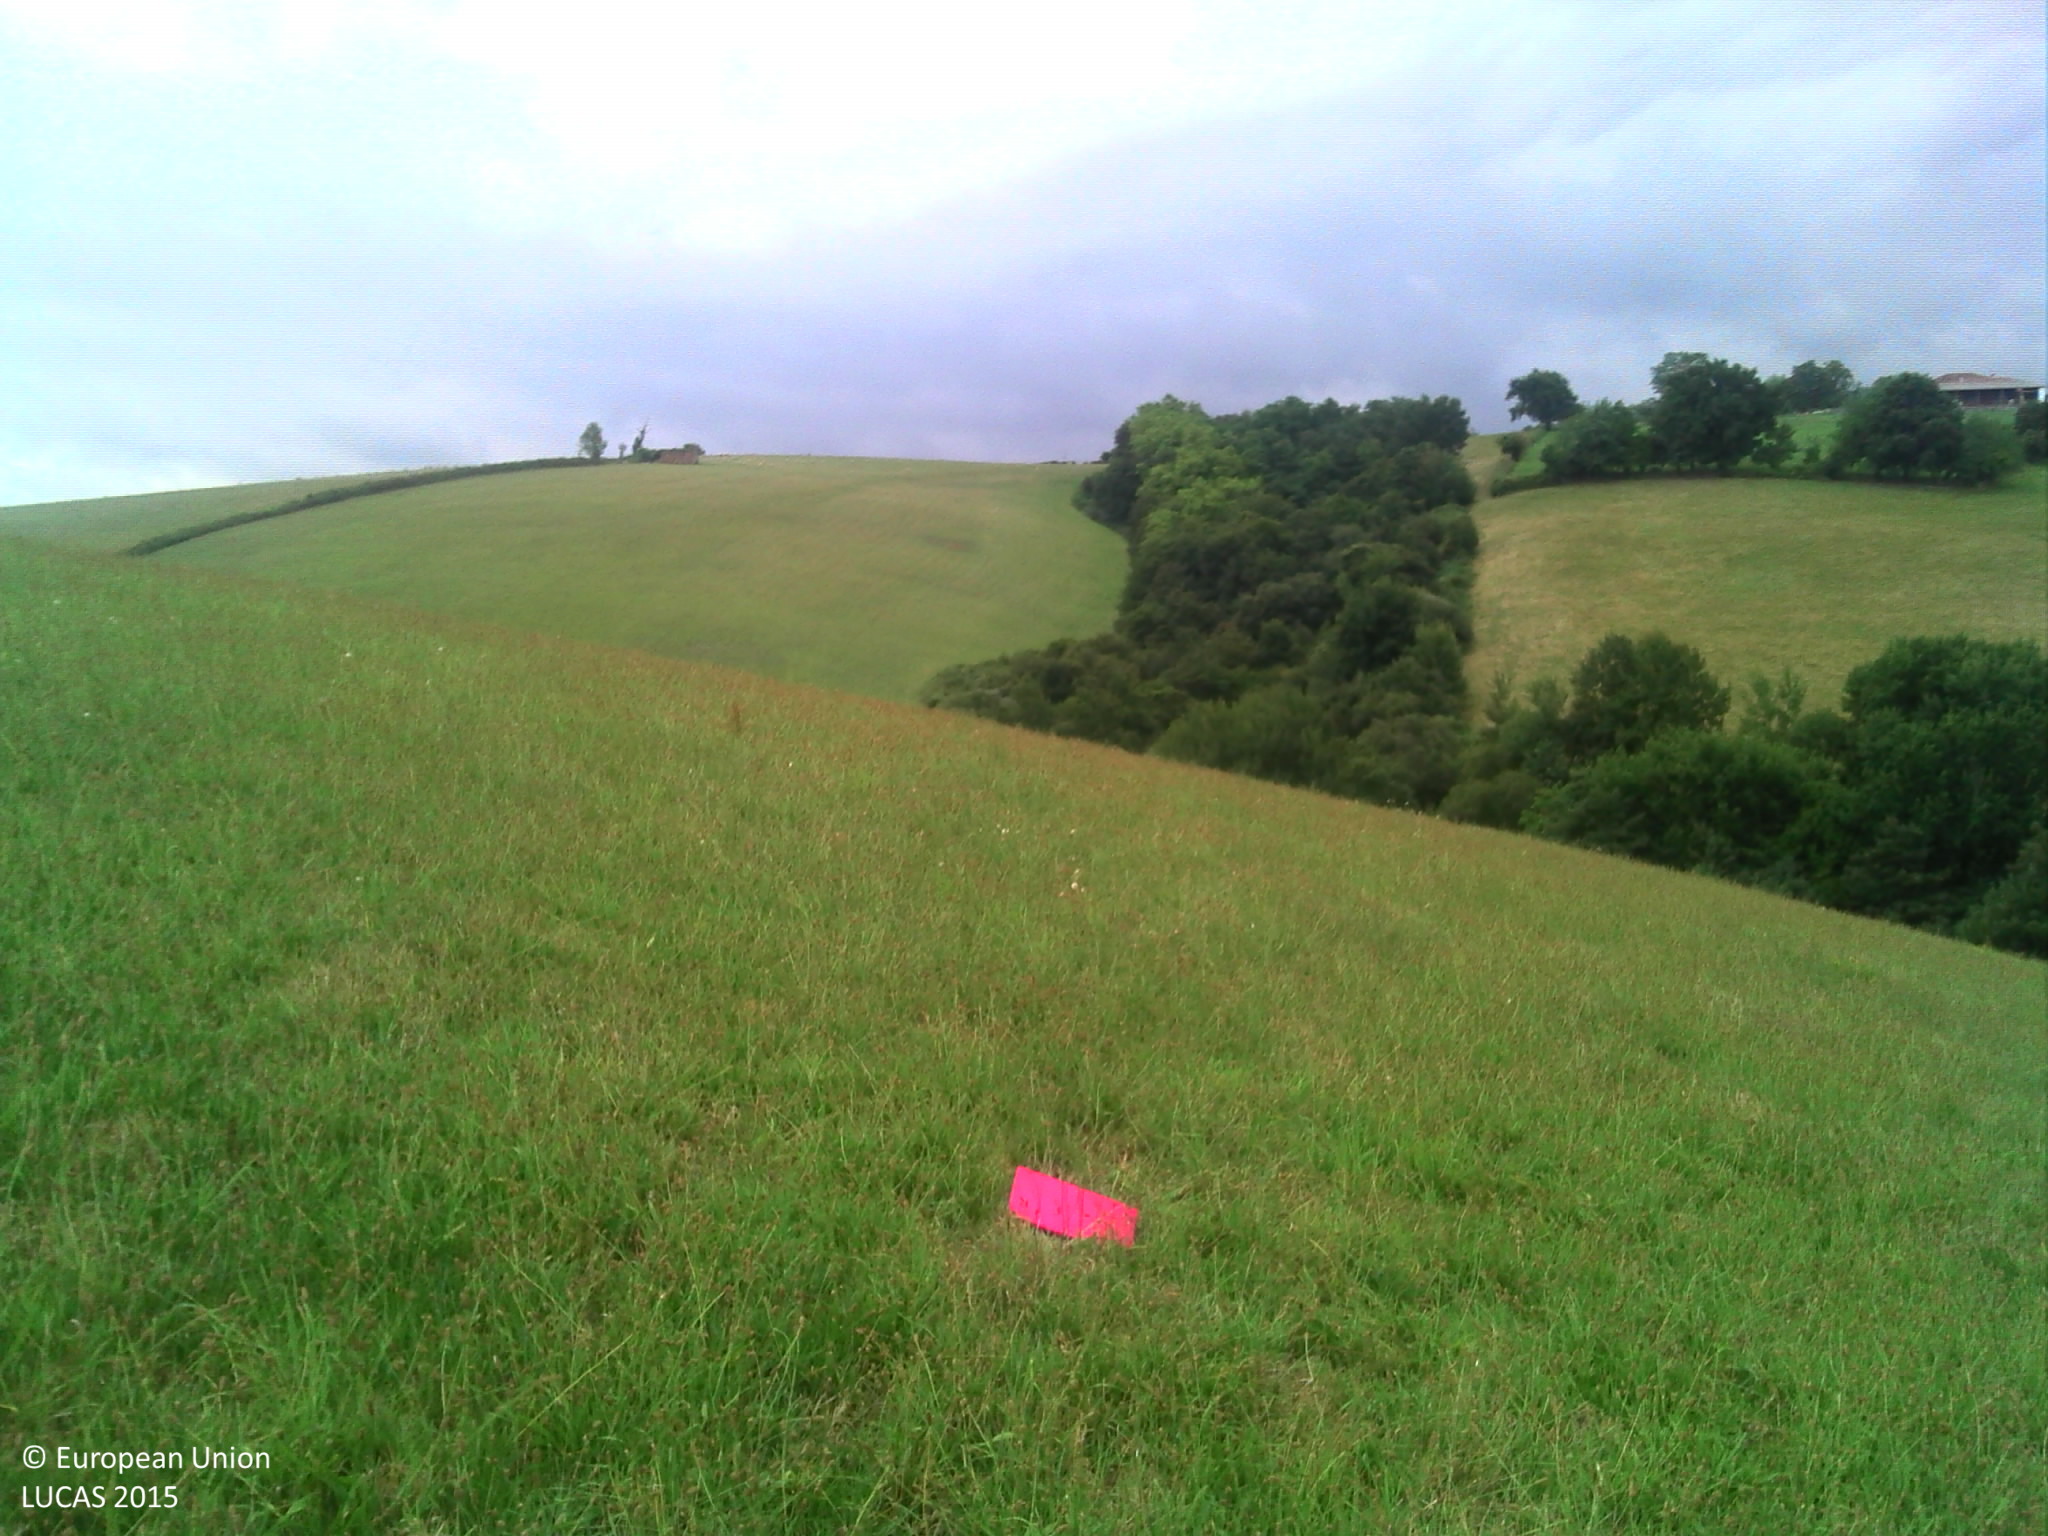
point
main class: Grassland
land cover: Grassland without tree/shrub cover
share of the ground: > 75 %
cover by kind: herbaceous plants 100 %
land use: Agriculture (excluding fallow land and kitchen gardens)
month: August
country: FR
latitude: 43.4156
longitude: -1.1919
